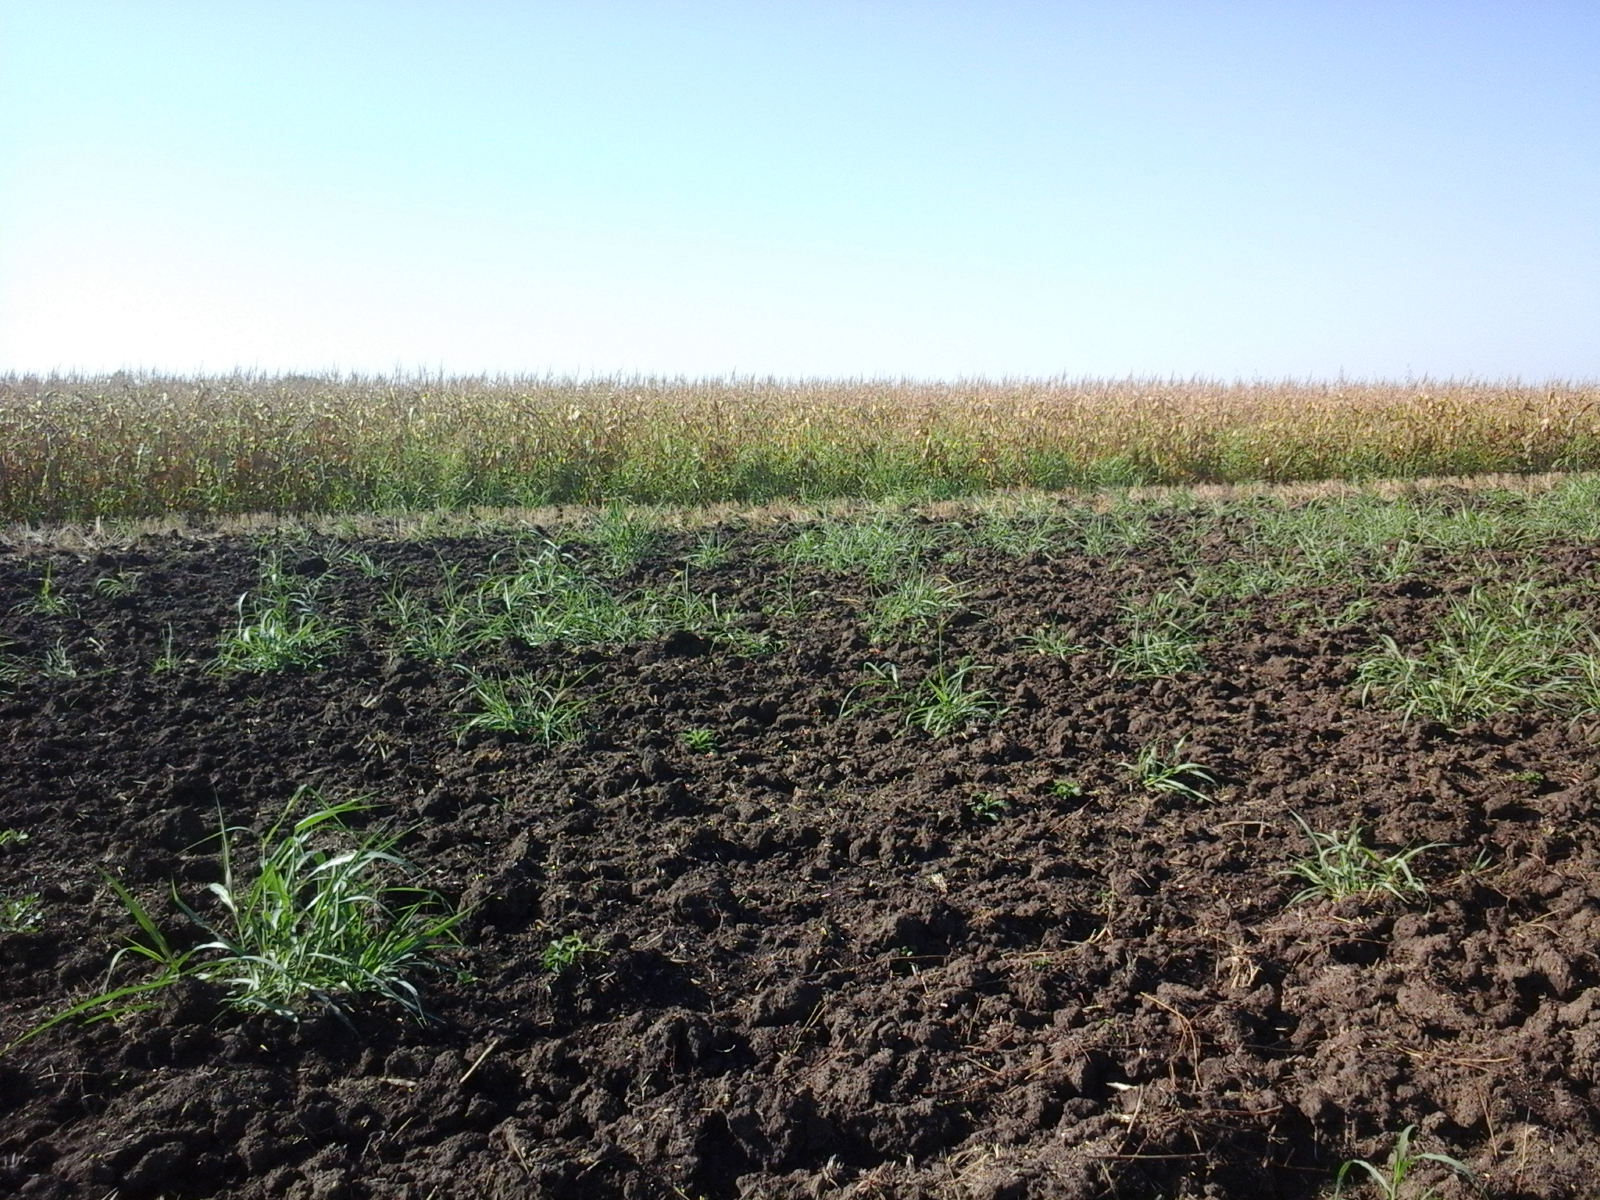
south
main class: Cropland
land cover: Common wheat
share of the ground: 10 - 25 %
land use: Agriculture (excluding fallow land and kitchen gardens)
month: August
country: RO
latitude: 46.0614
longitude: 21.1091
